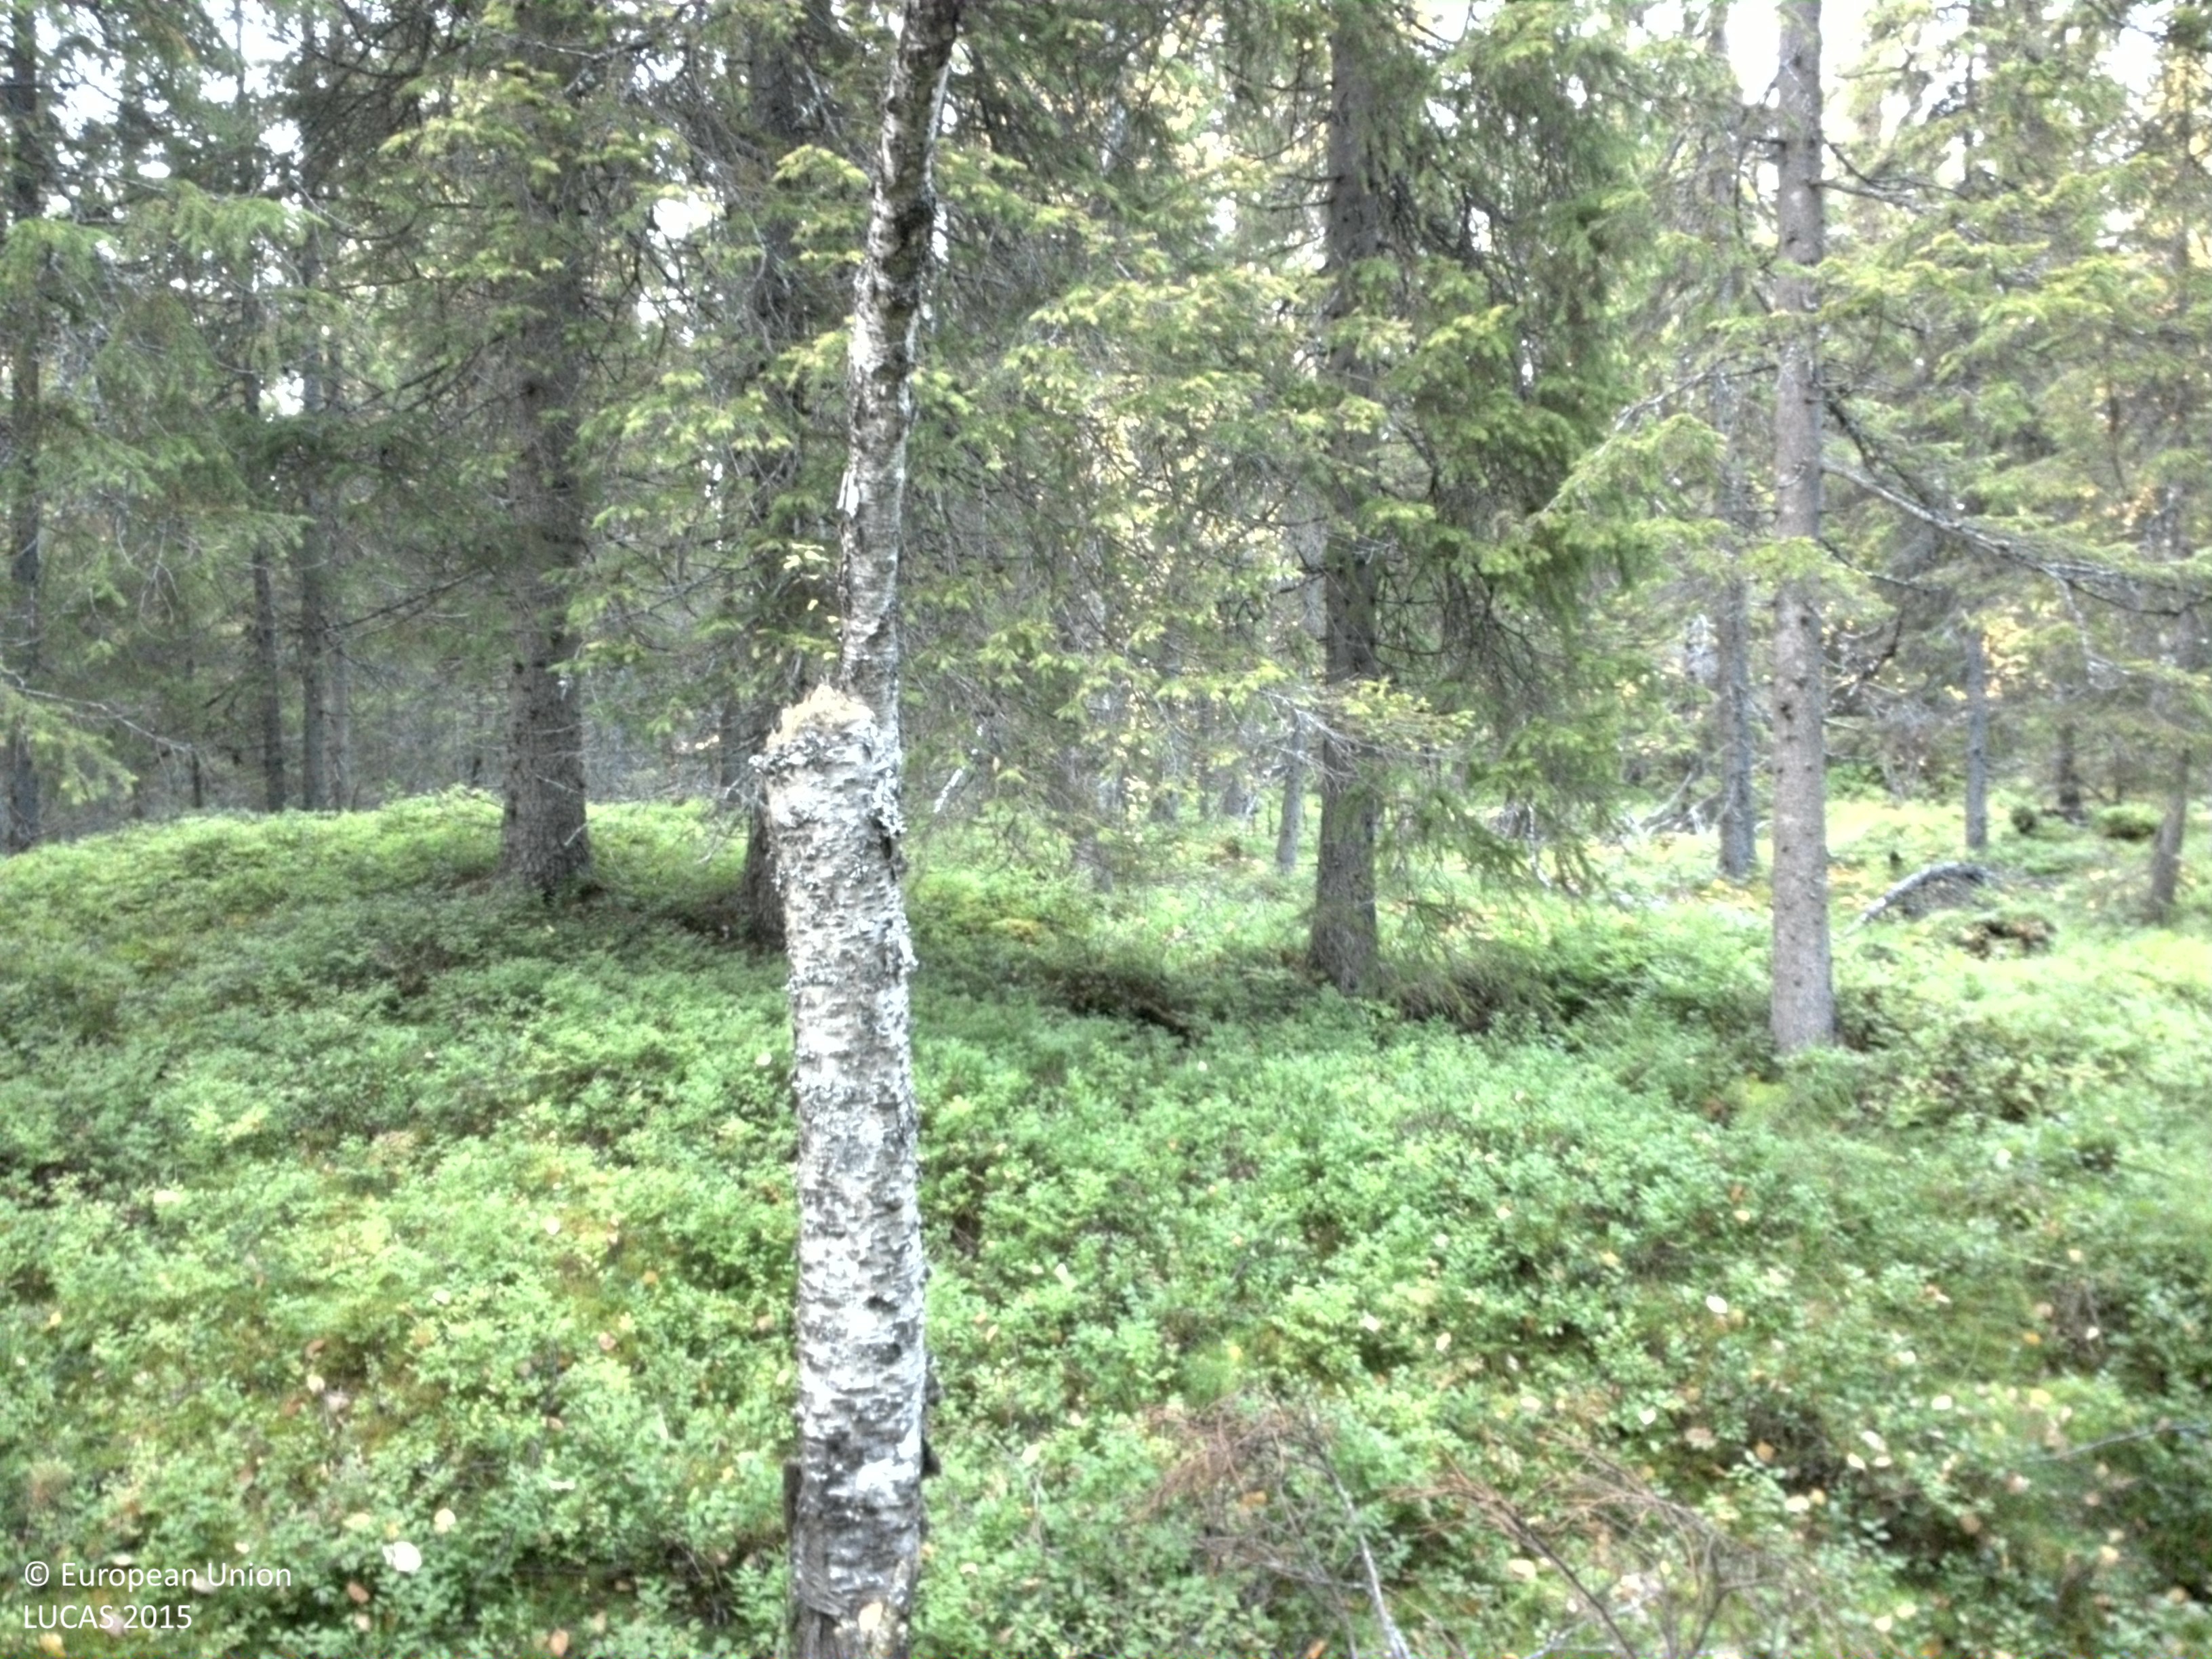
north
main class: Woodland
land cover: Spruce dominated coniferous woodland
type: boreal forest
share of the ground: 25 - 50 %
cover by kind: shrubs 40 %, coniferous forest trees 35 %, lichens and mosses 15 %, broadleaved forest trees 10 %
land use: Forestry
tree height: > 5 m
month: September
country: SE
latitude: 65.3230
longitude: 16.3384
